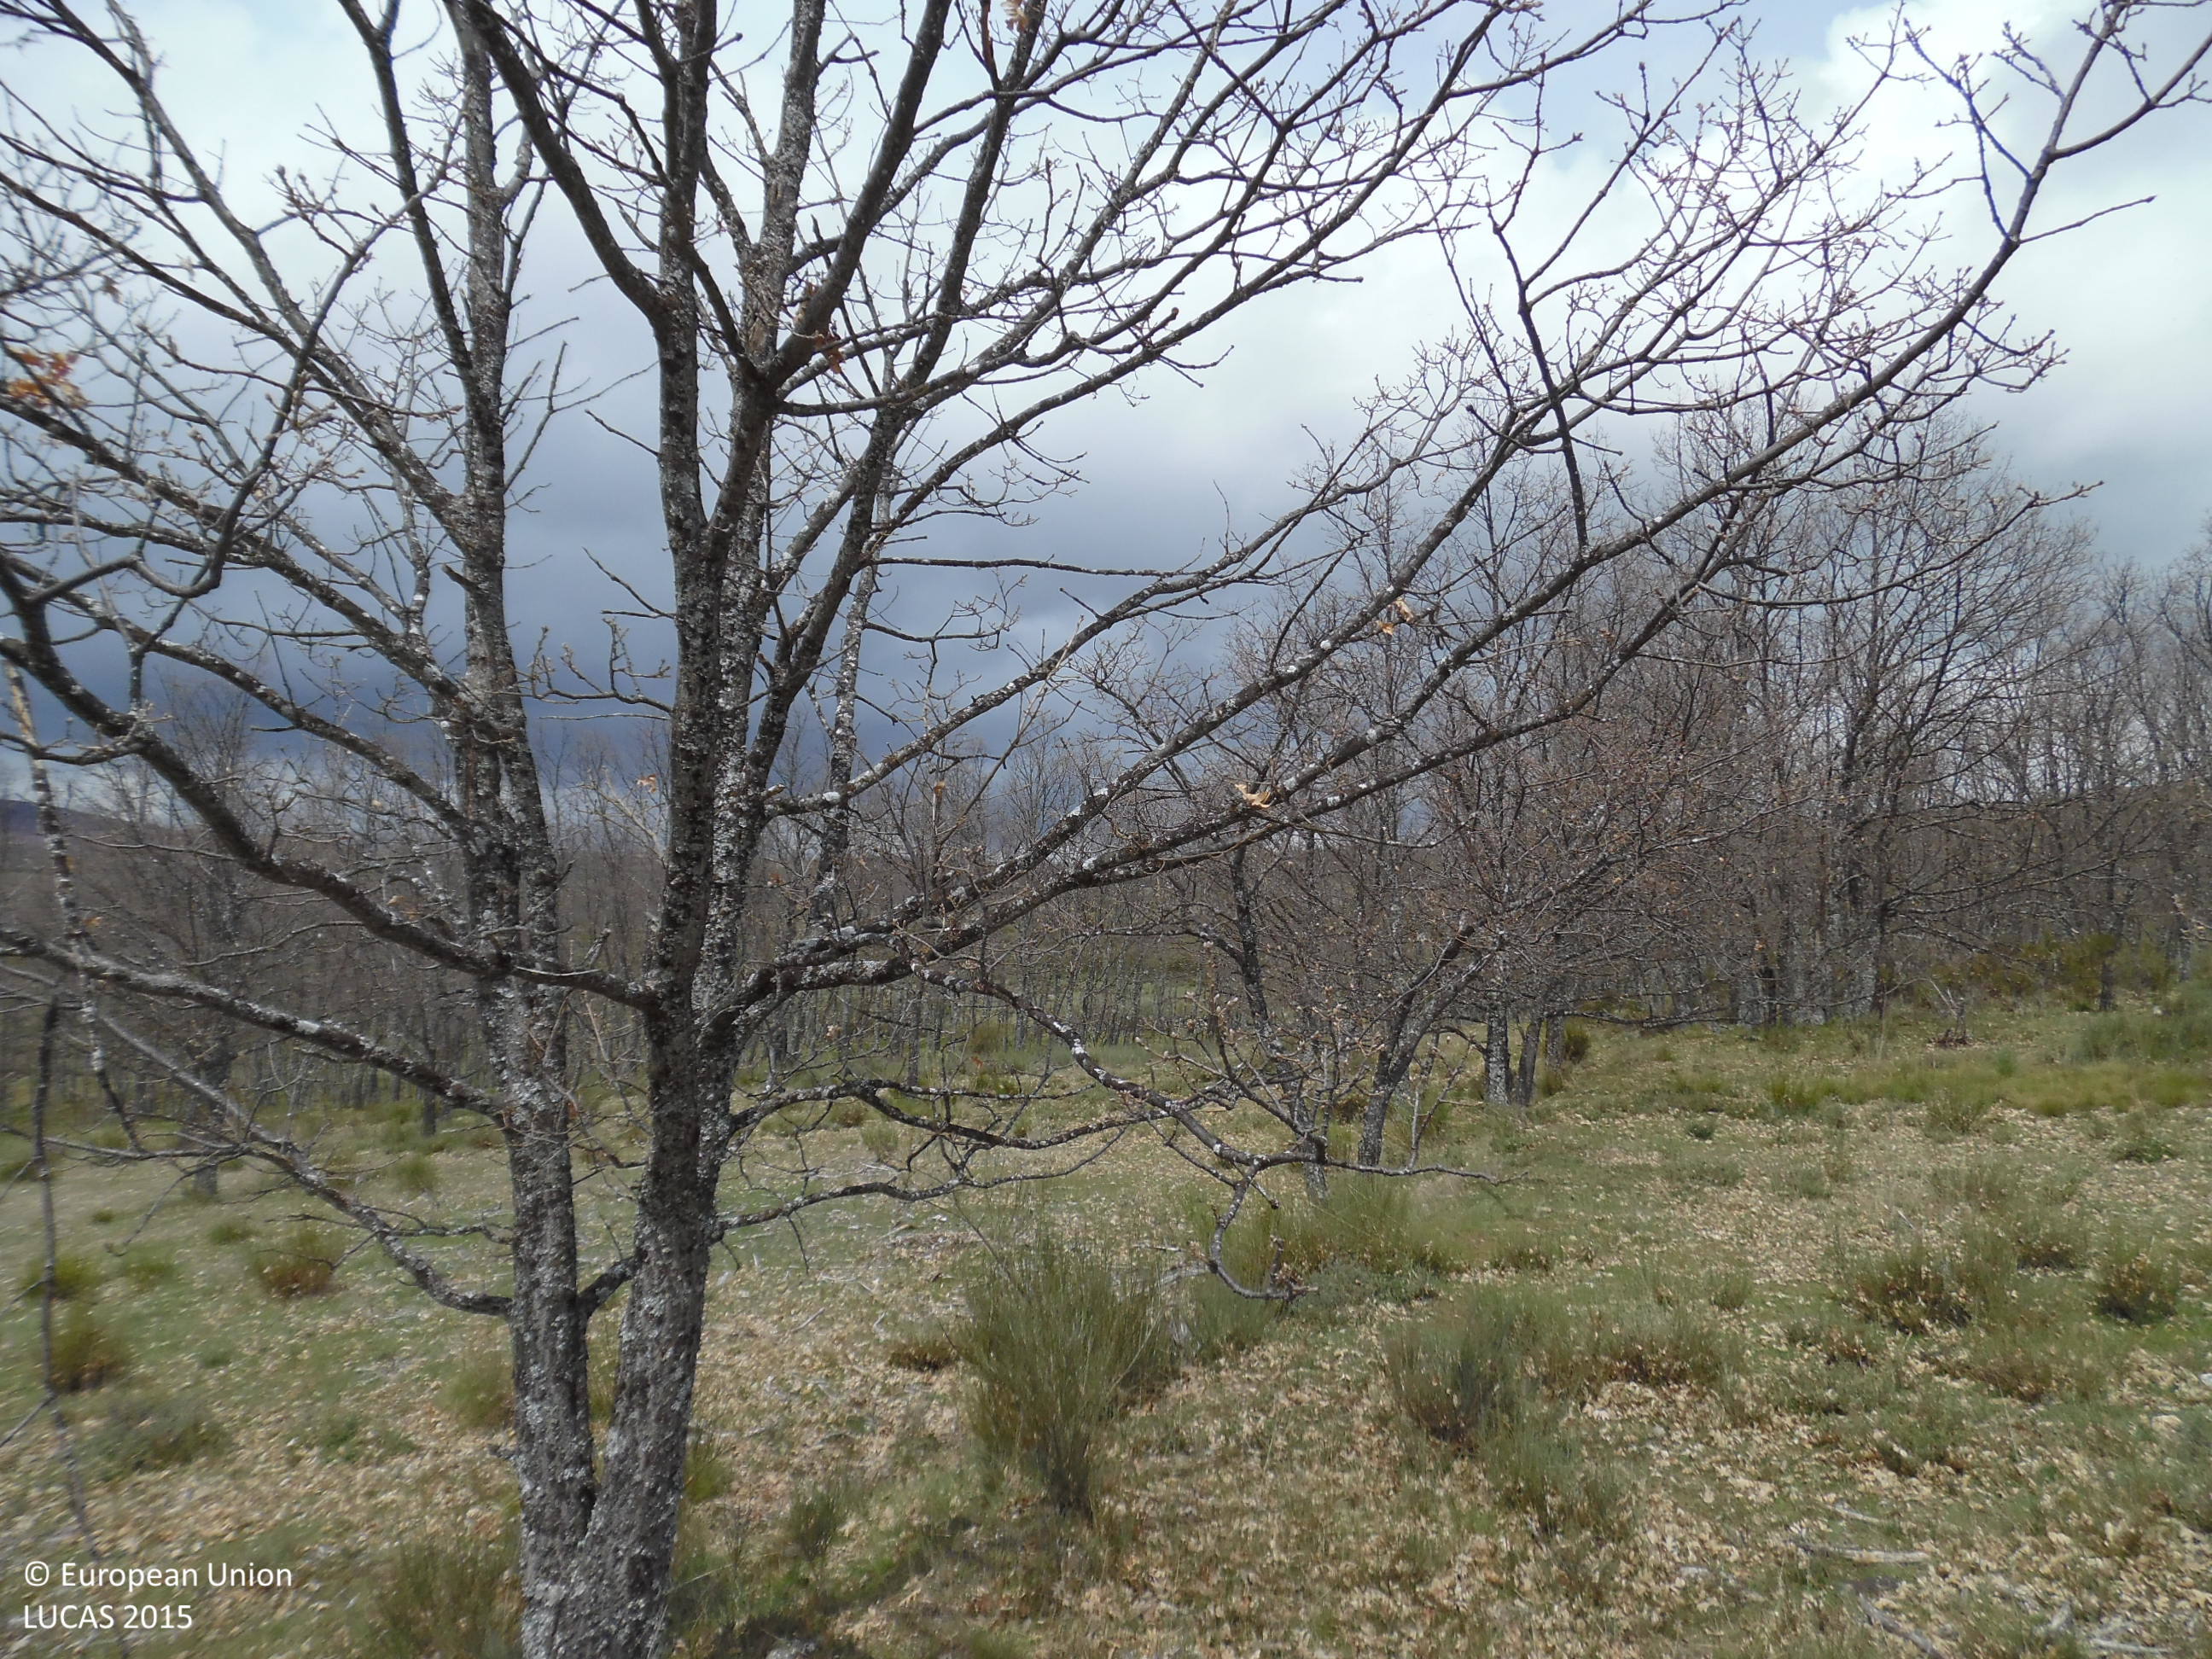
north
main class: Shrubland
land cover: Shrubland with sparse tree cover
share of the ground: 50 - 75 %
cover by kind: shrubs 65 %, herbaceous plants 30 %, broadleaved forest trees 5 %
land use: Abandoned areas
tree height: > 5 m
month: April
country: ES
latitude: 42.4204
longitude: -6.3362
